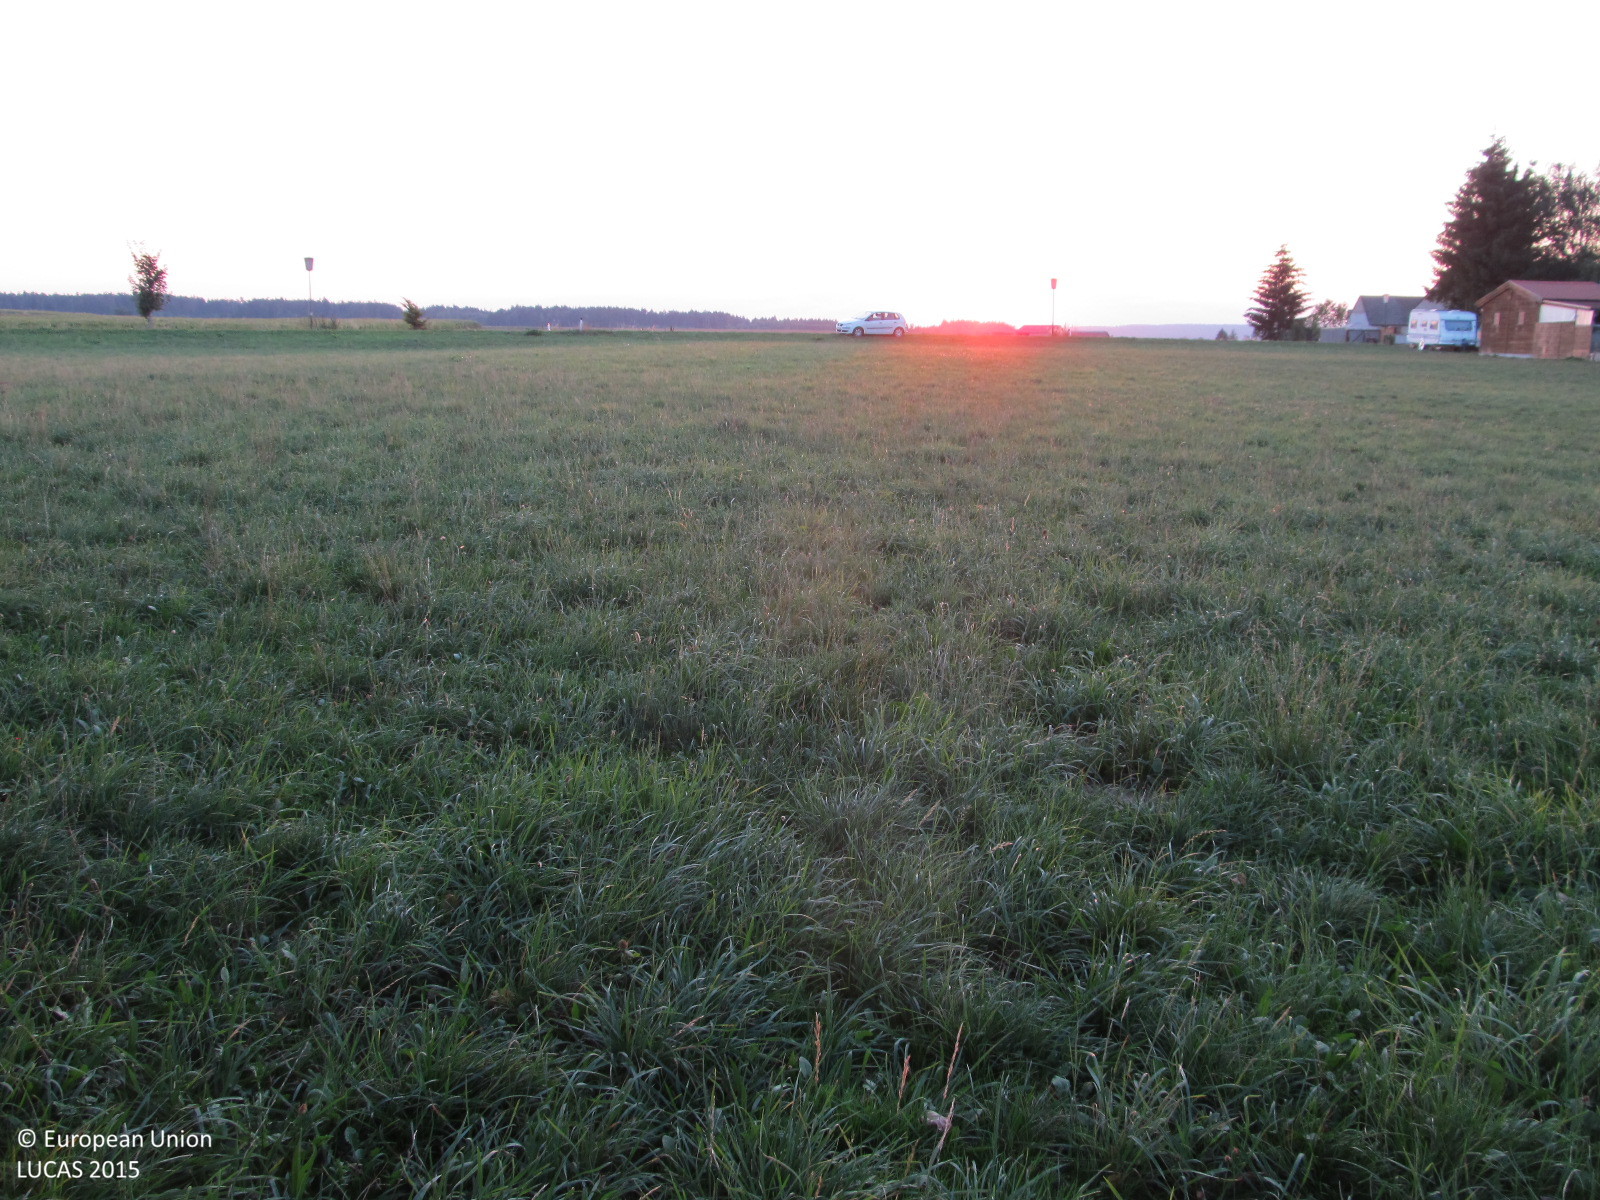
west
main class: Grassland
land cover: Grassland without tree/shrub cover
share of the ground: > 75 %
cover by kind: herbaceous plants 100 %
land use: Agriculture (excluding fallow land and kitchen gardens)
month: August
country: AT
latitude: 48.7556
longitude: 15.4575
